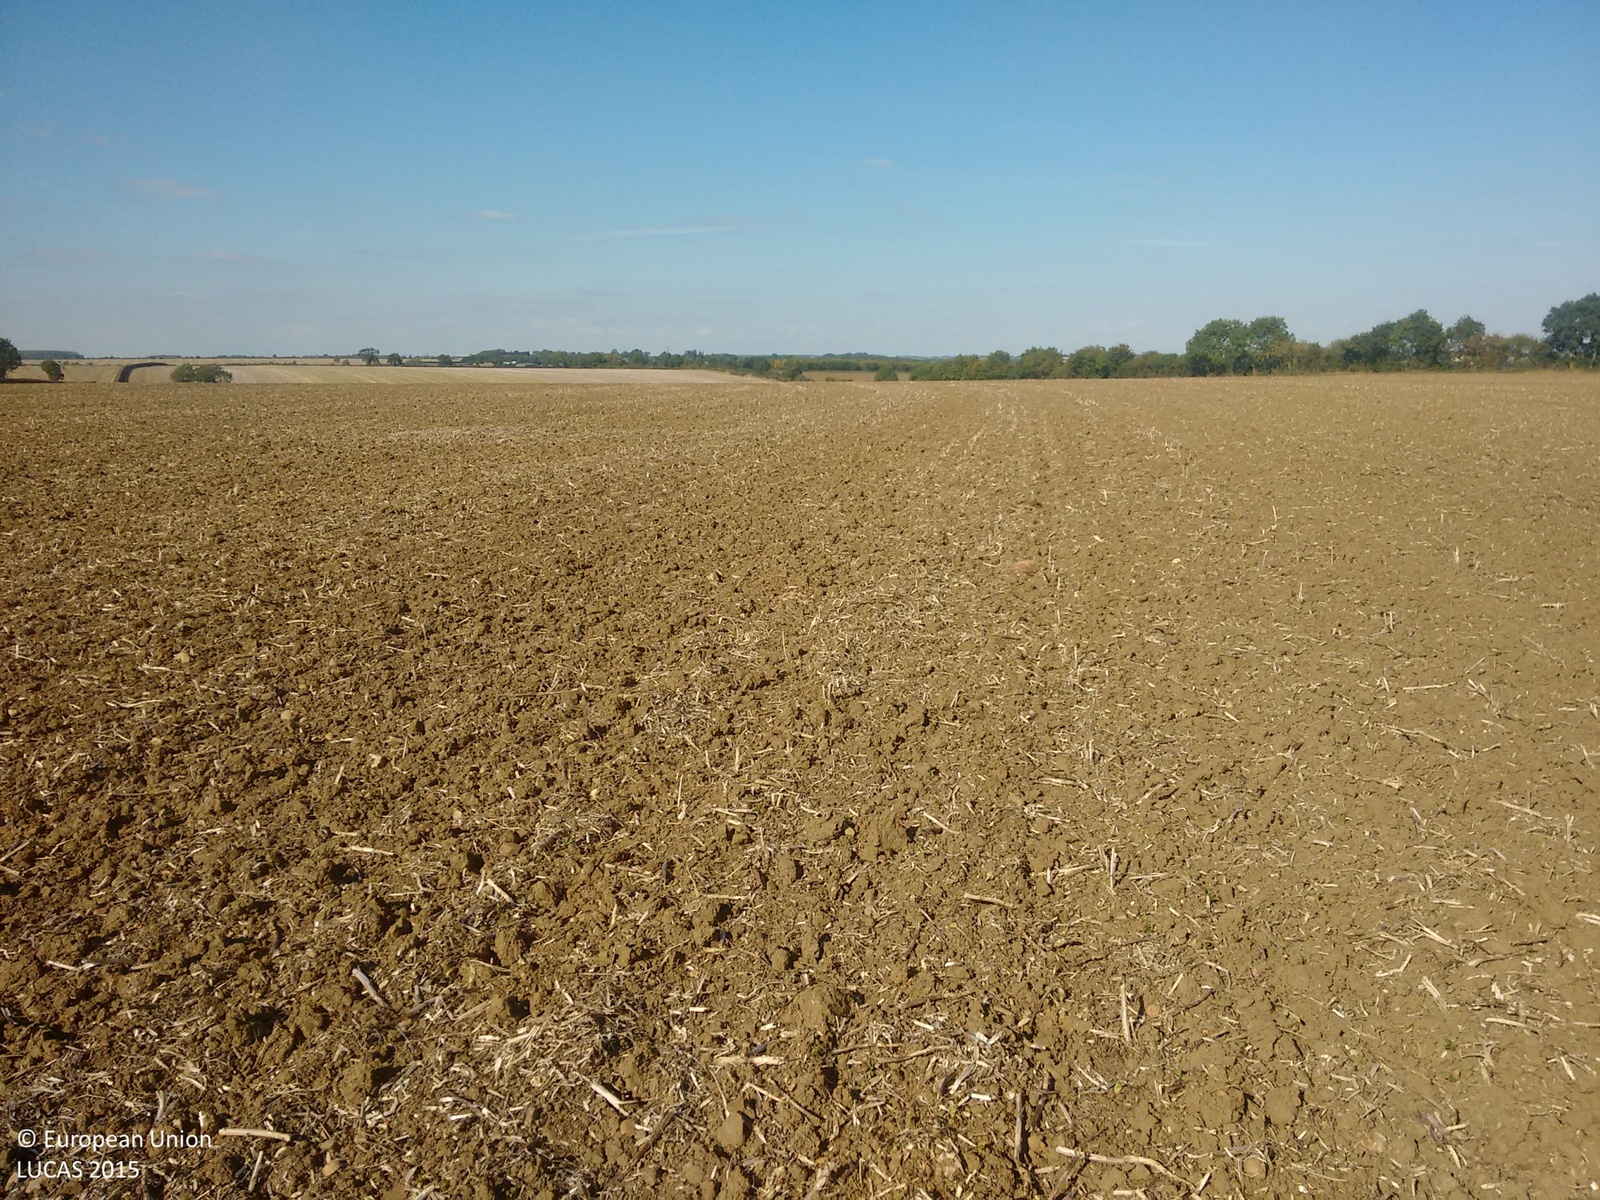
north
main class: Cropland
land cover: Rape and turnip rape
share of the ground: 10 - 25 %
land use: Agriculture (excluding fallow land and kitchen gardens)
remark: Harvested field
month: September
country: GB
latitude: 52.3937
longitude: -0.3674
